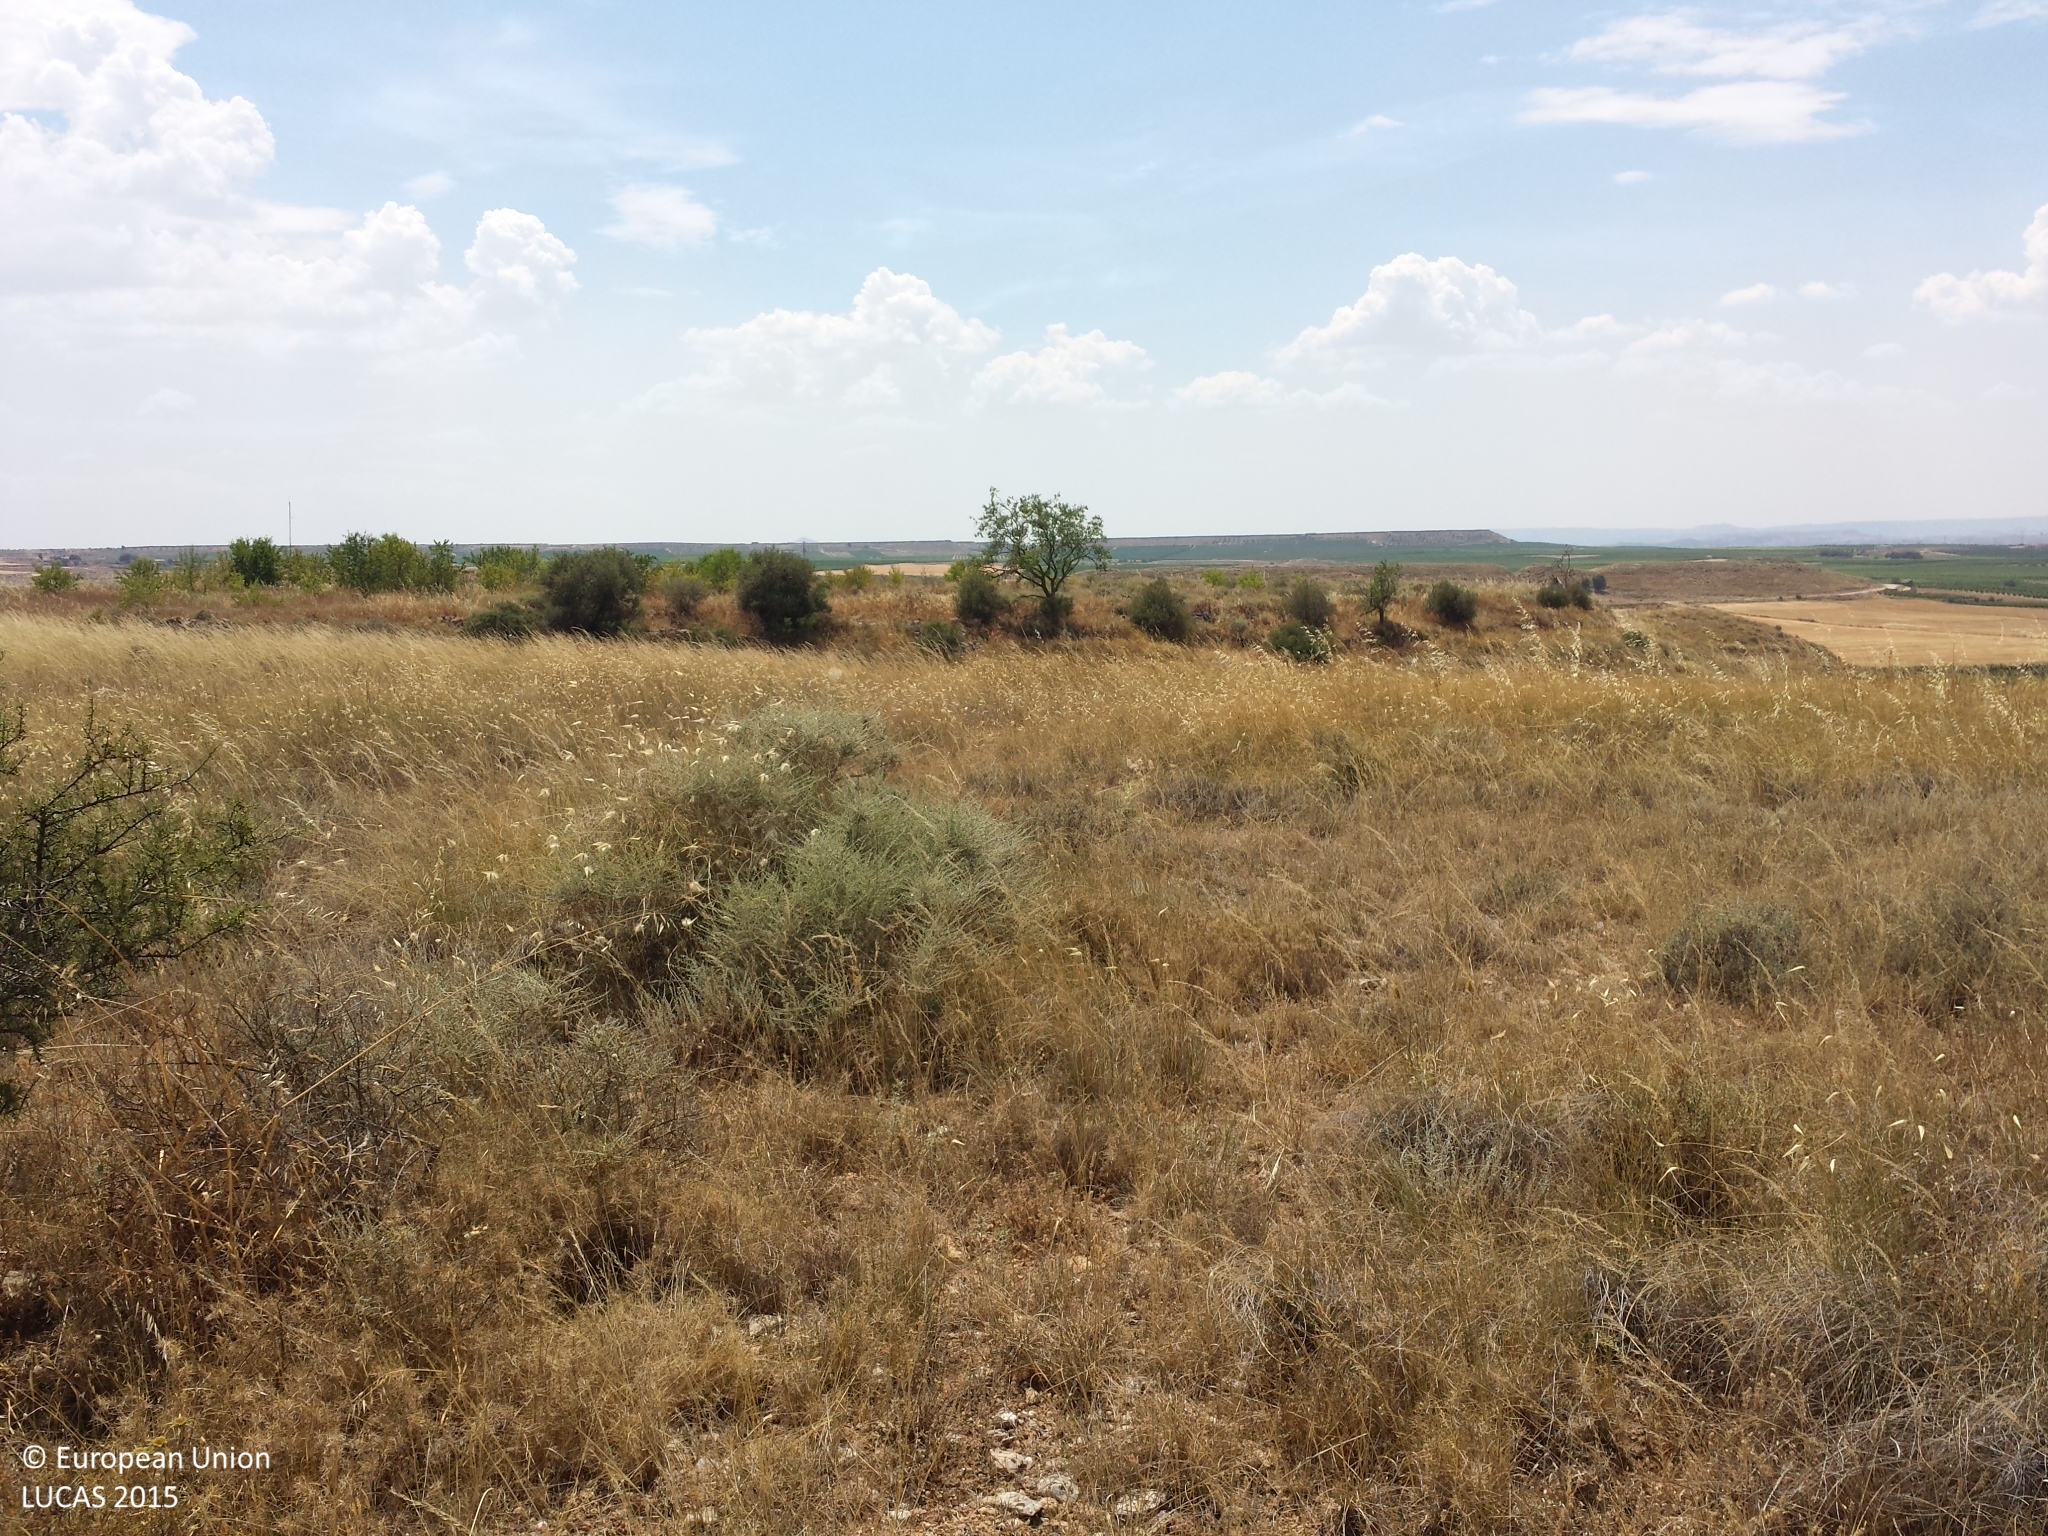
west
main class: Shrubland
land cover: Shrubland without tree cover
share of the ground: > 75 %
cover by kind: shrubs 75 %, herbaceous plants 20 %, consolidated bare surface 5 %
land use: Abandoned areas
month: June
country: ES
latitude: 41.5437
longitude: 0.6019
